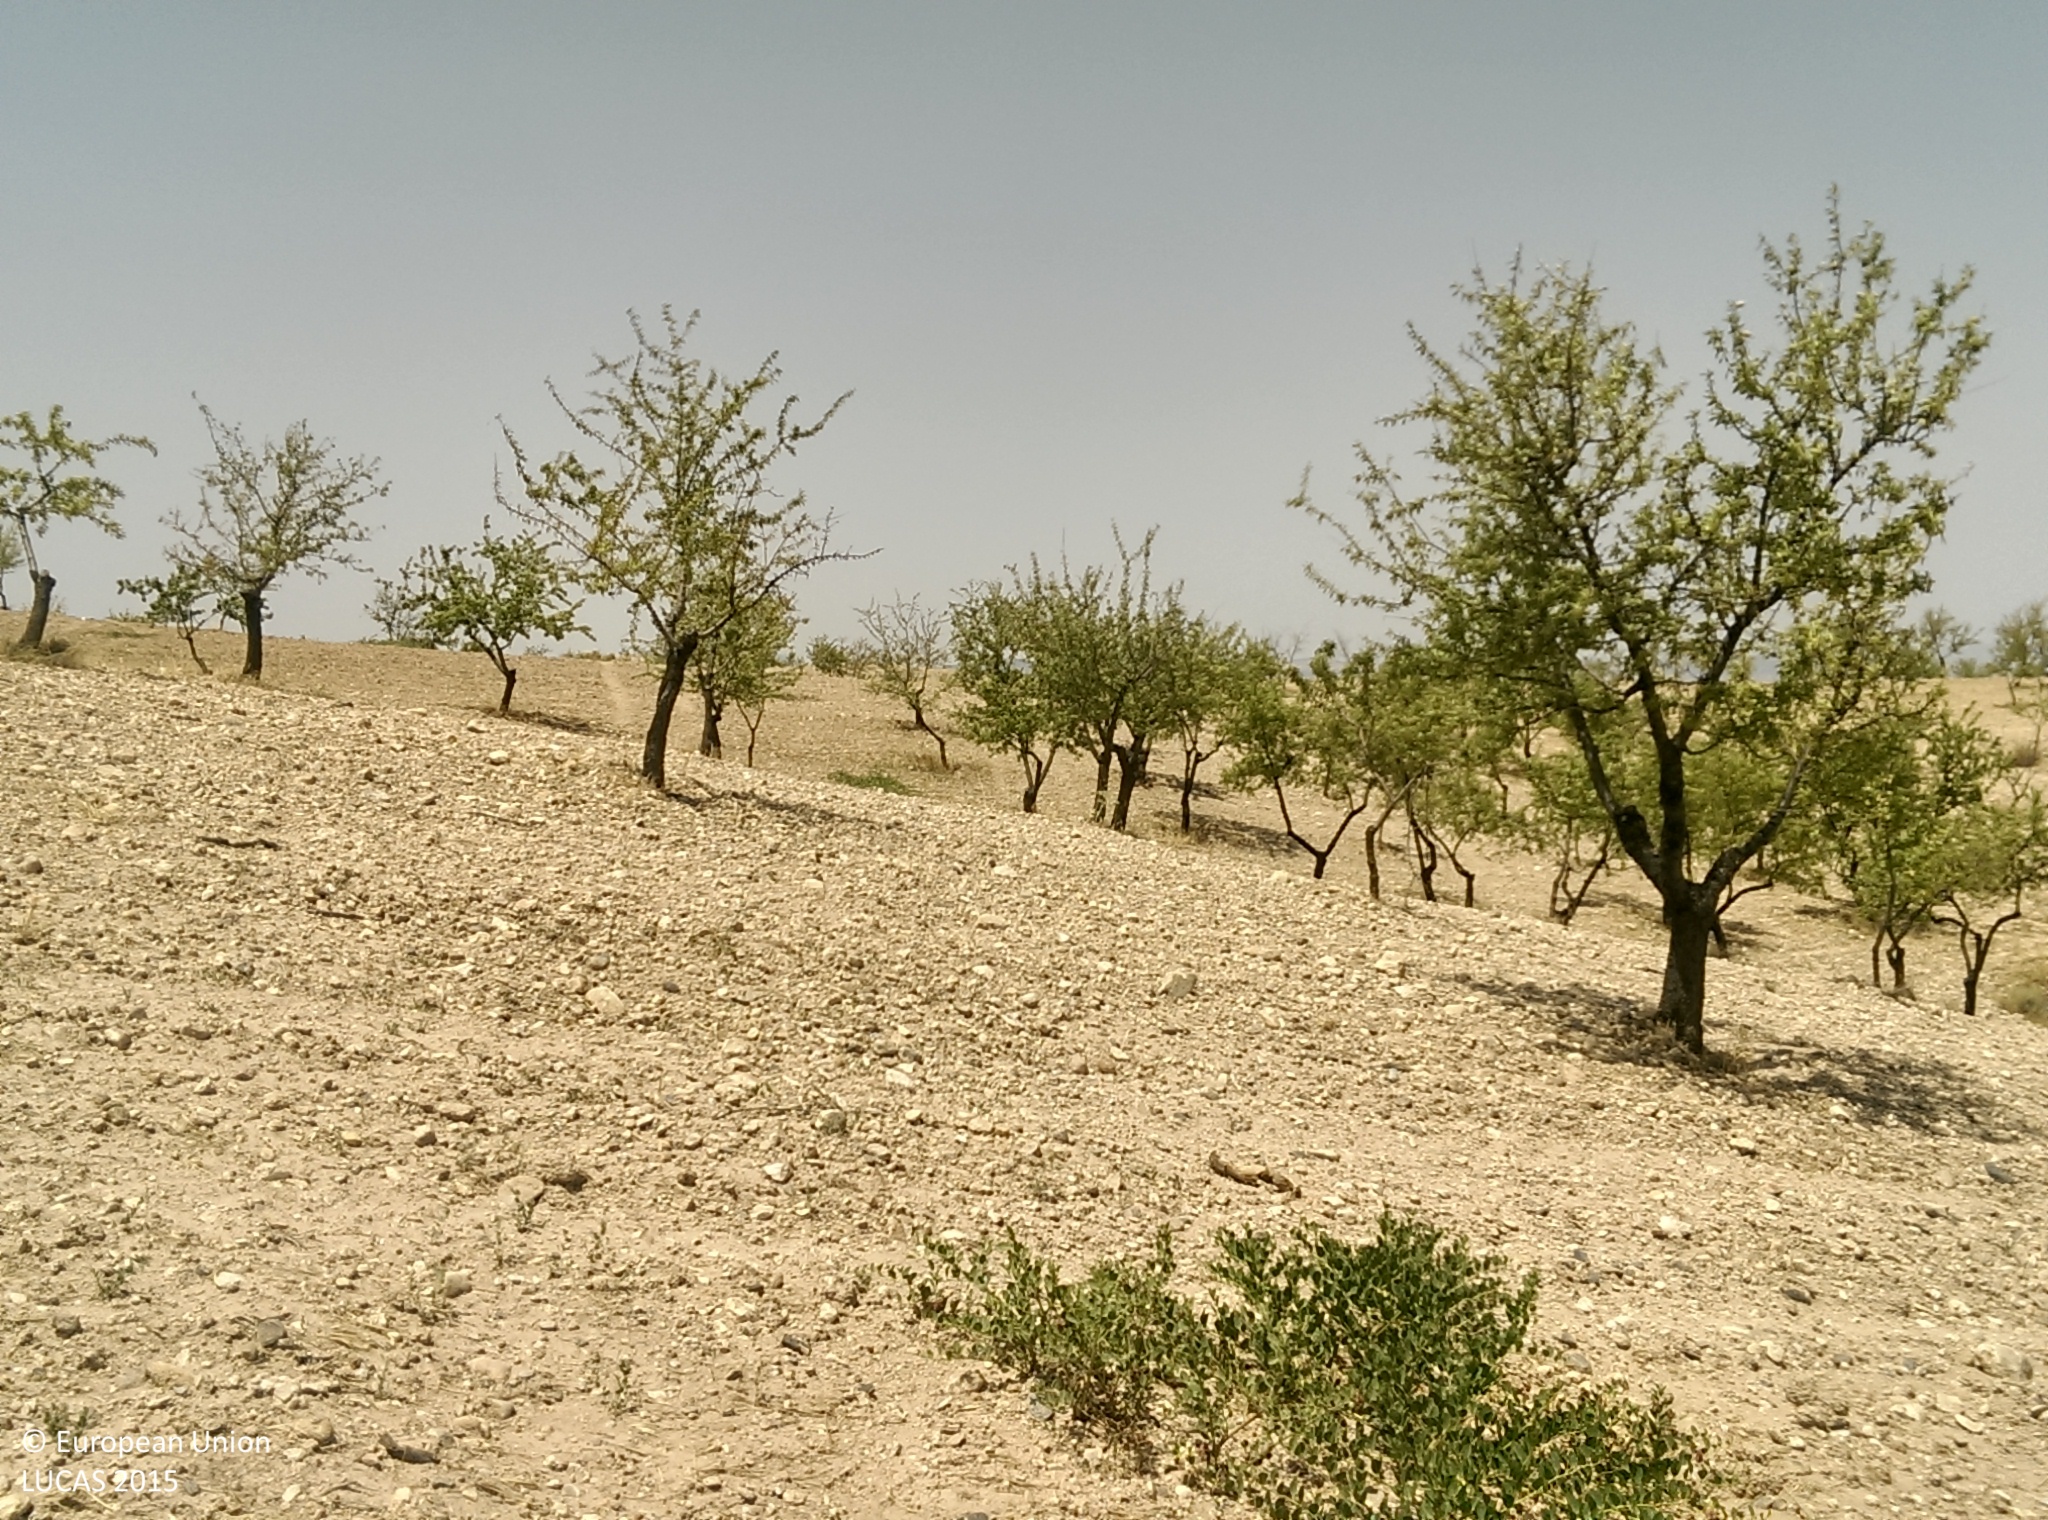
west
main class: Cropland
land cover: Nuts trees
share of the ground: < 10 %
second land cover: Other bare soil
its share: > 75 %
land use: Agriculture (excluding fallow land and kitchen gardens)
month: July
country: ES
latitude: 37.5222
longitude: -2.9216
